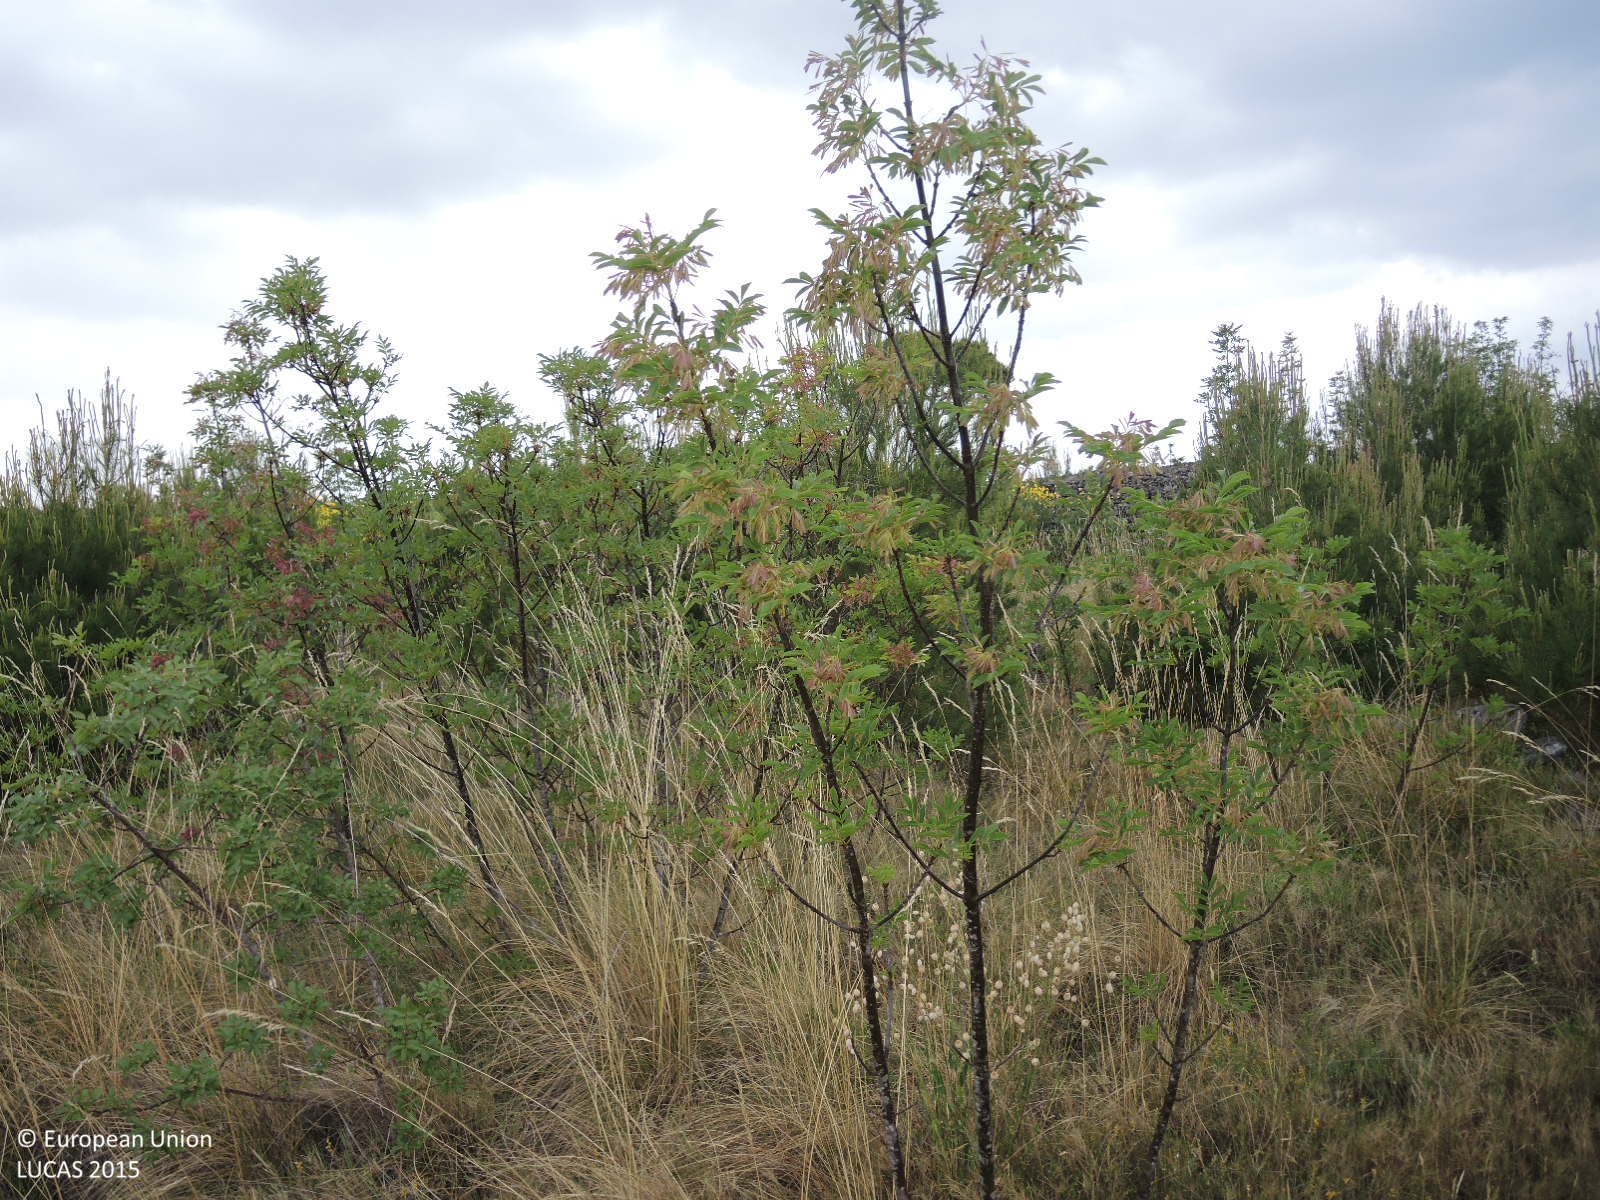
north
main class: Woodland
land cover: Pine dominated coniferous woodland
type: coniferous forest of the mediterranean region
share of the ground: 10 - 25 %
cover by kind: herbaceous plants 60 %, shrubs 20 %, coniferous forest trees 15 %, unconsolidated bare surface 5 %
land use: Semi-natural and natural areas not in use
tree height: < 5 m
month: May
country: HR
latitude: 43.7341
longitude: 15.8387
